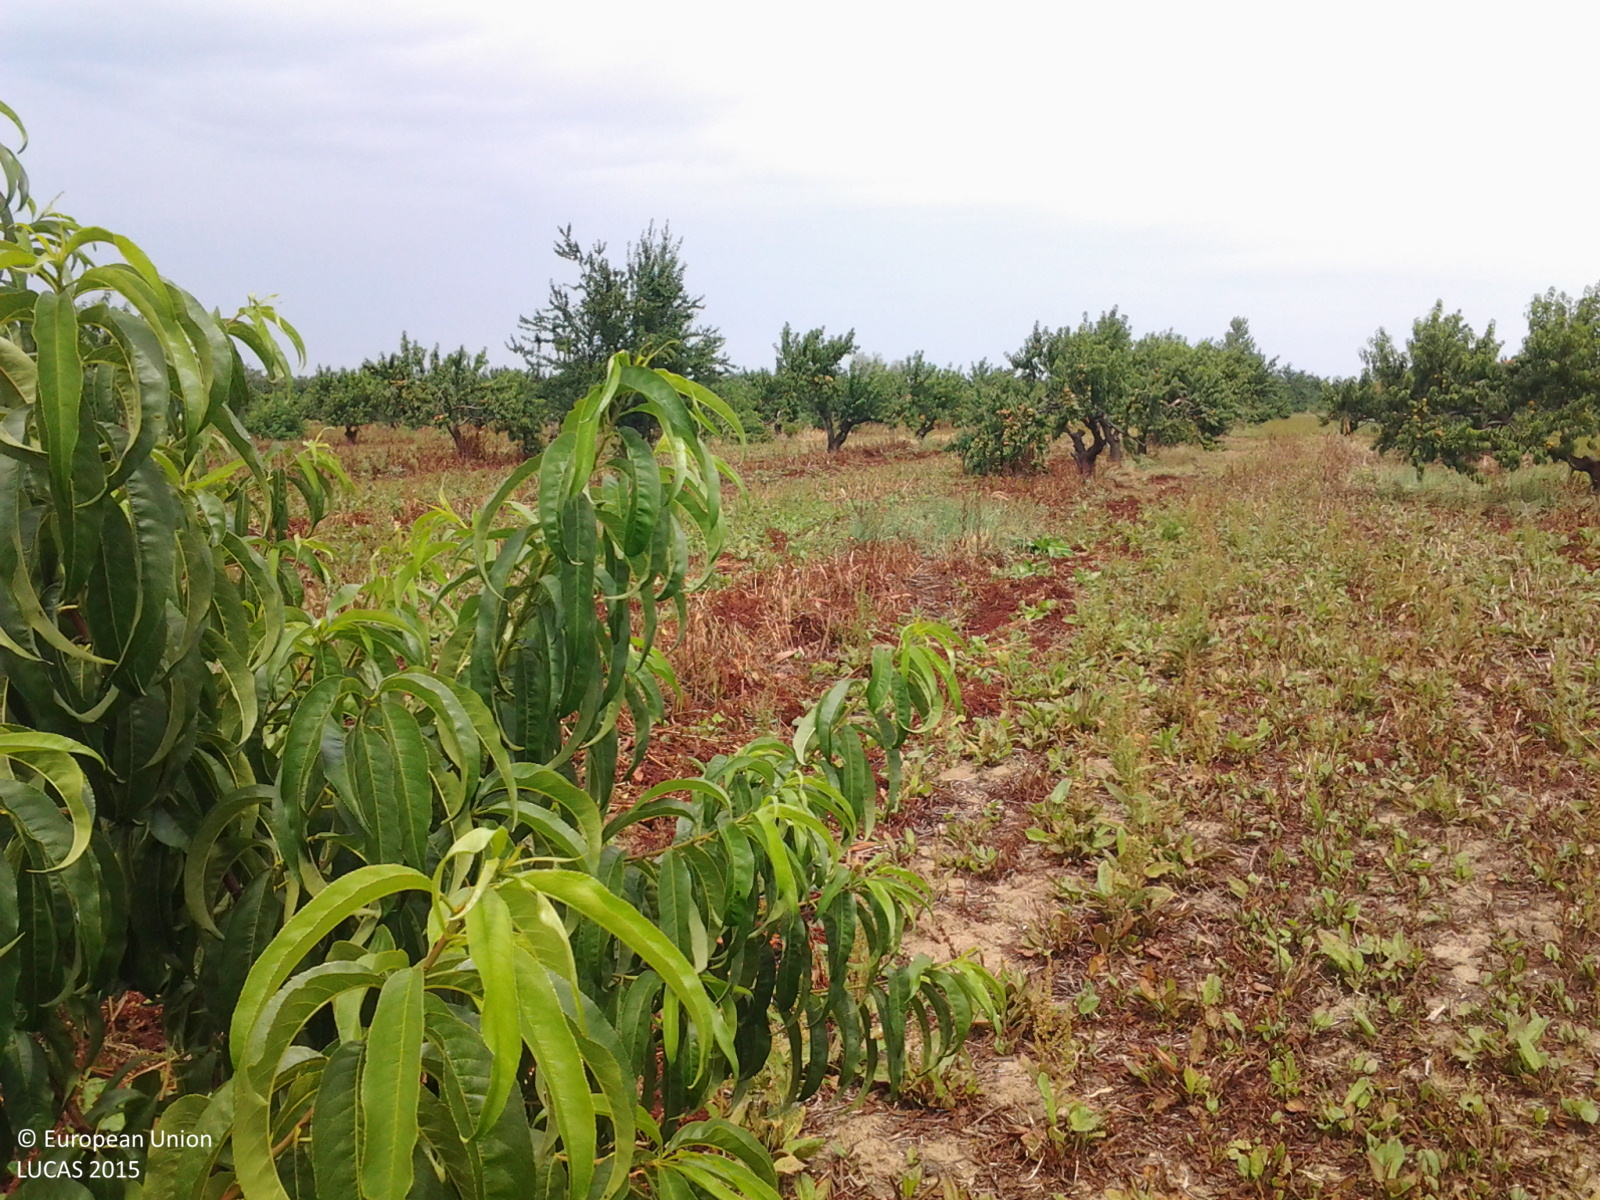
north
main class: Cropland
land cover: Other fruit trees and berries
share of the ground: 25 - 50 %
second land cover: Spontaneously vegetated surfaces
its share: 50 - 75 %
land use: Agriculture (excluding fallow land and kitchen gardens)
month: July
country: HU
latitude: 47.2685
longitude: 20.4848
